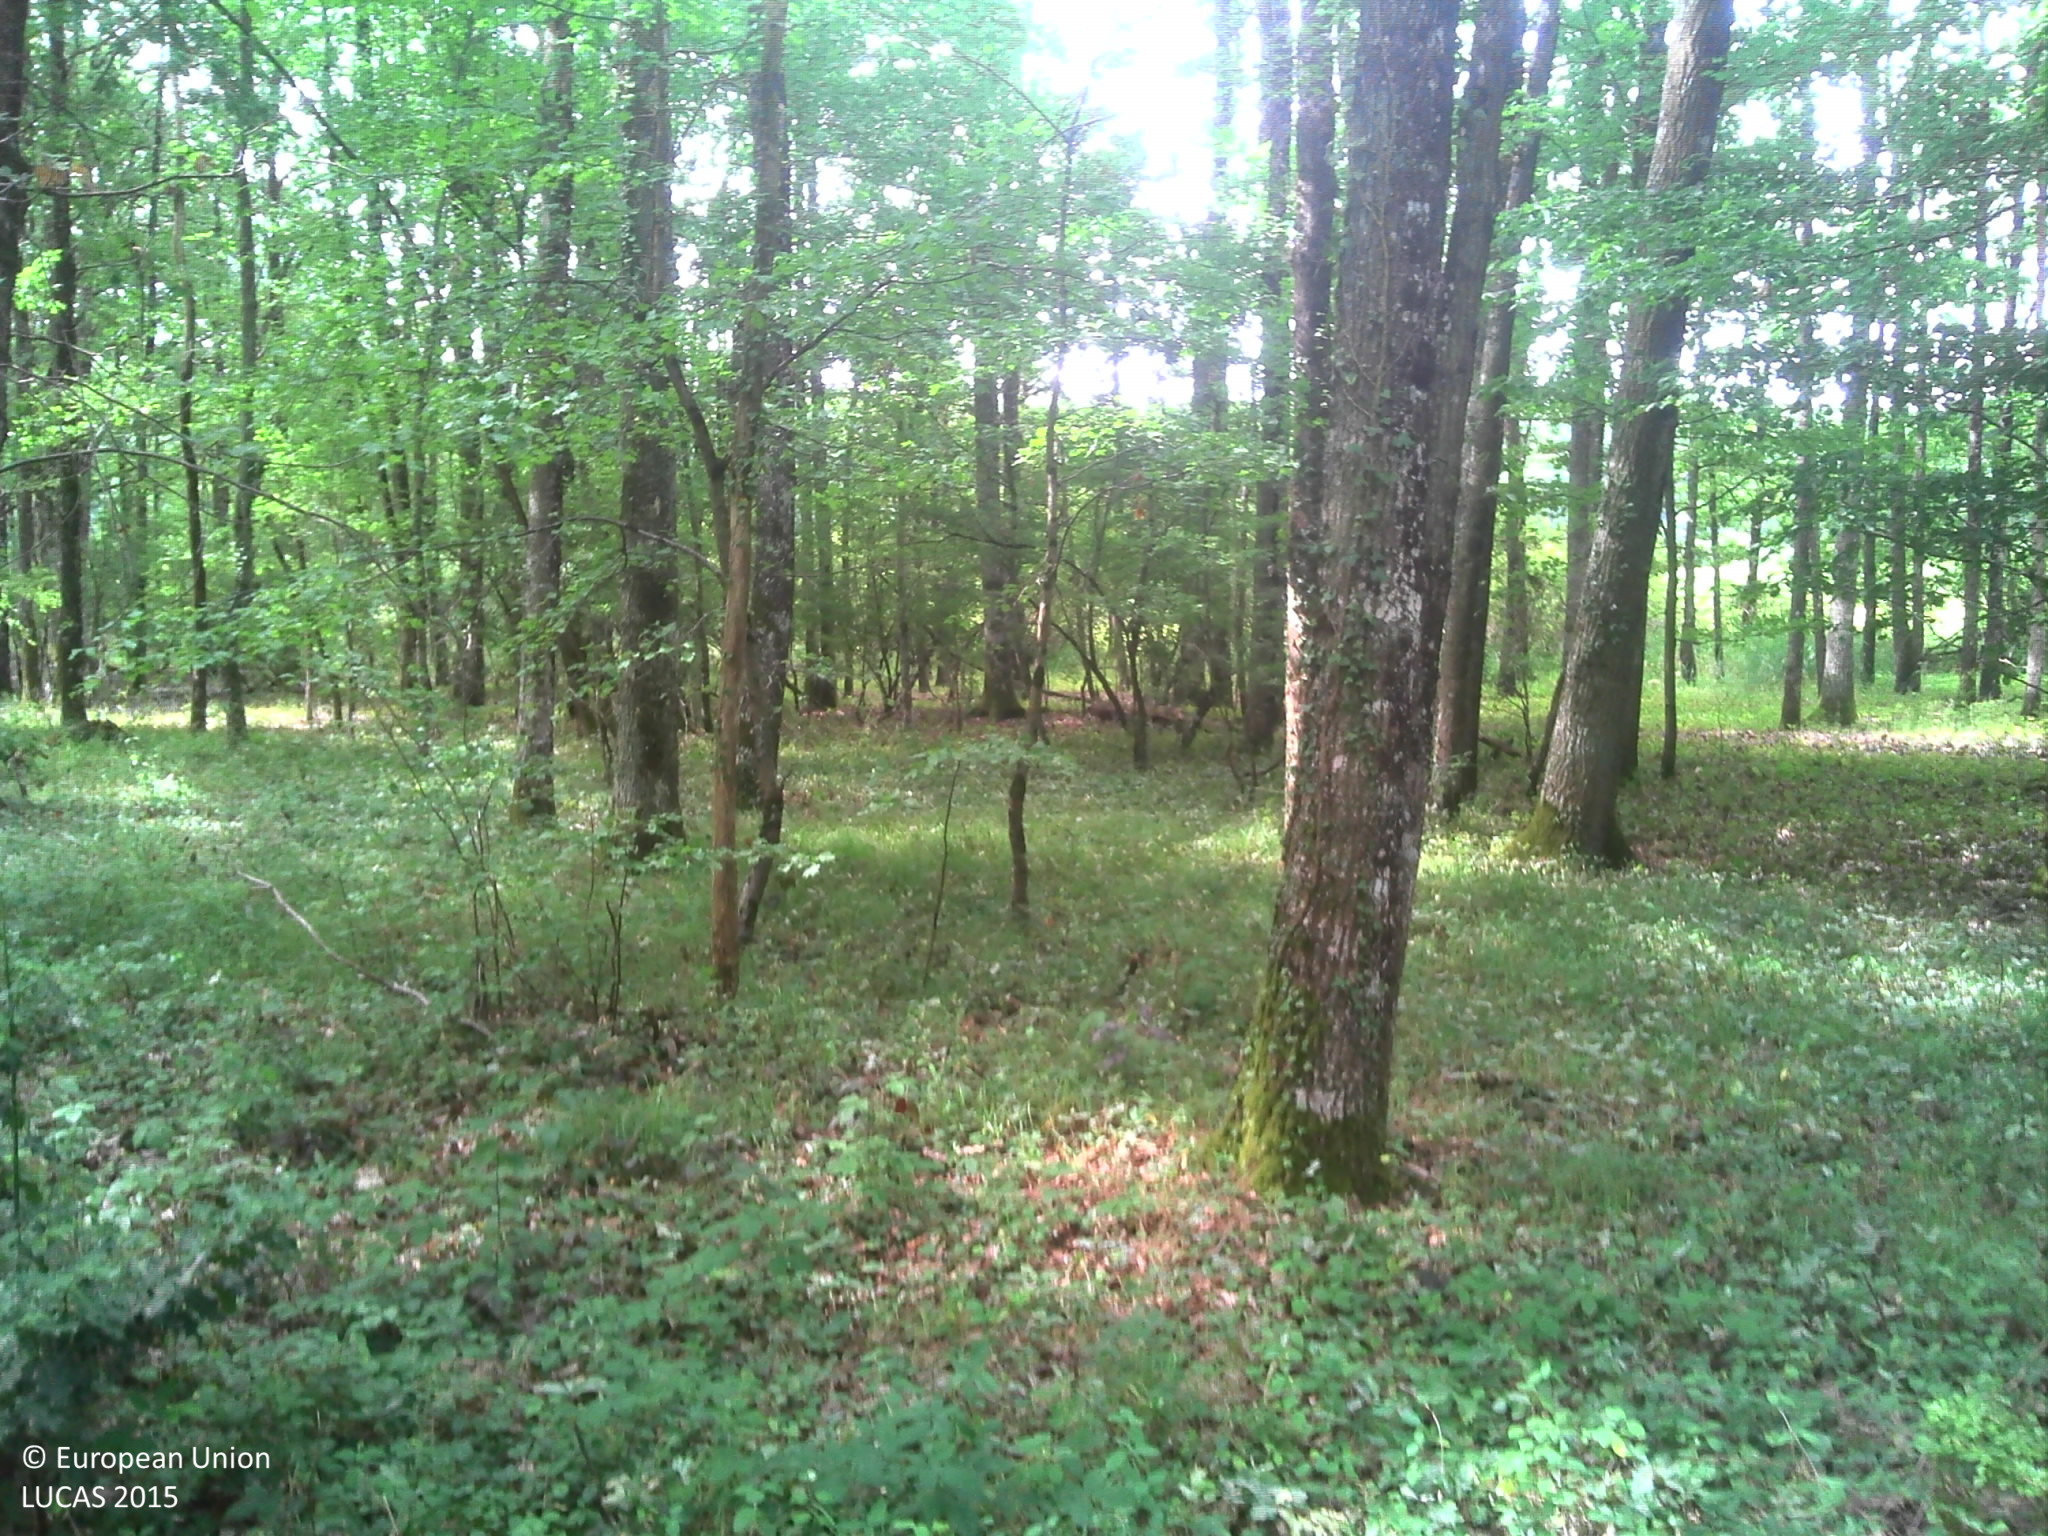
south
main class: Woodland
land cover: Broadleaved woodland
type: mesophytic deciduous forest
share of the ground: > 75 %
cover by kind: herbaceous plants 40 %, unconsolidated bare surface 40 %, broadleaved forest trees 20 %
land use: Forestry
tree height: > 5 m
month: June
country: FR
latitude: 47.3658
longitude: 1.4454
